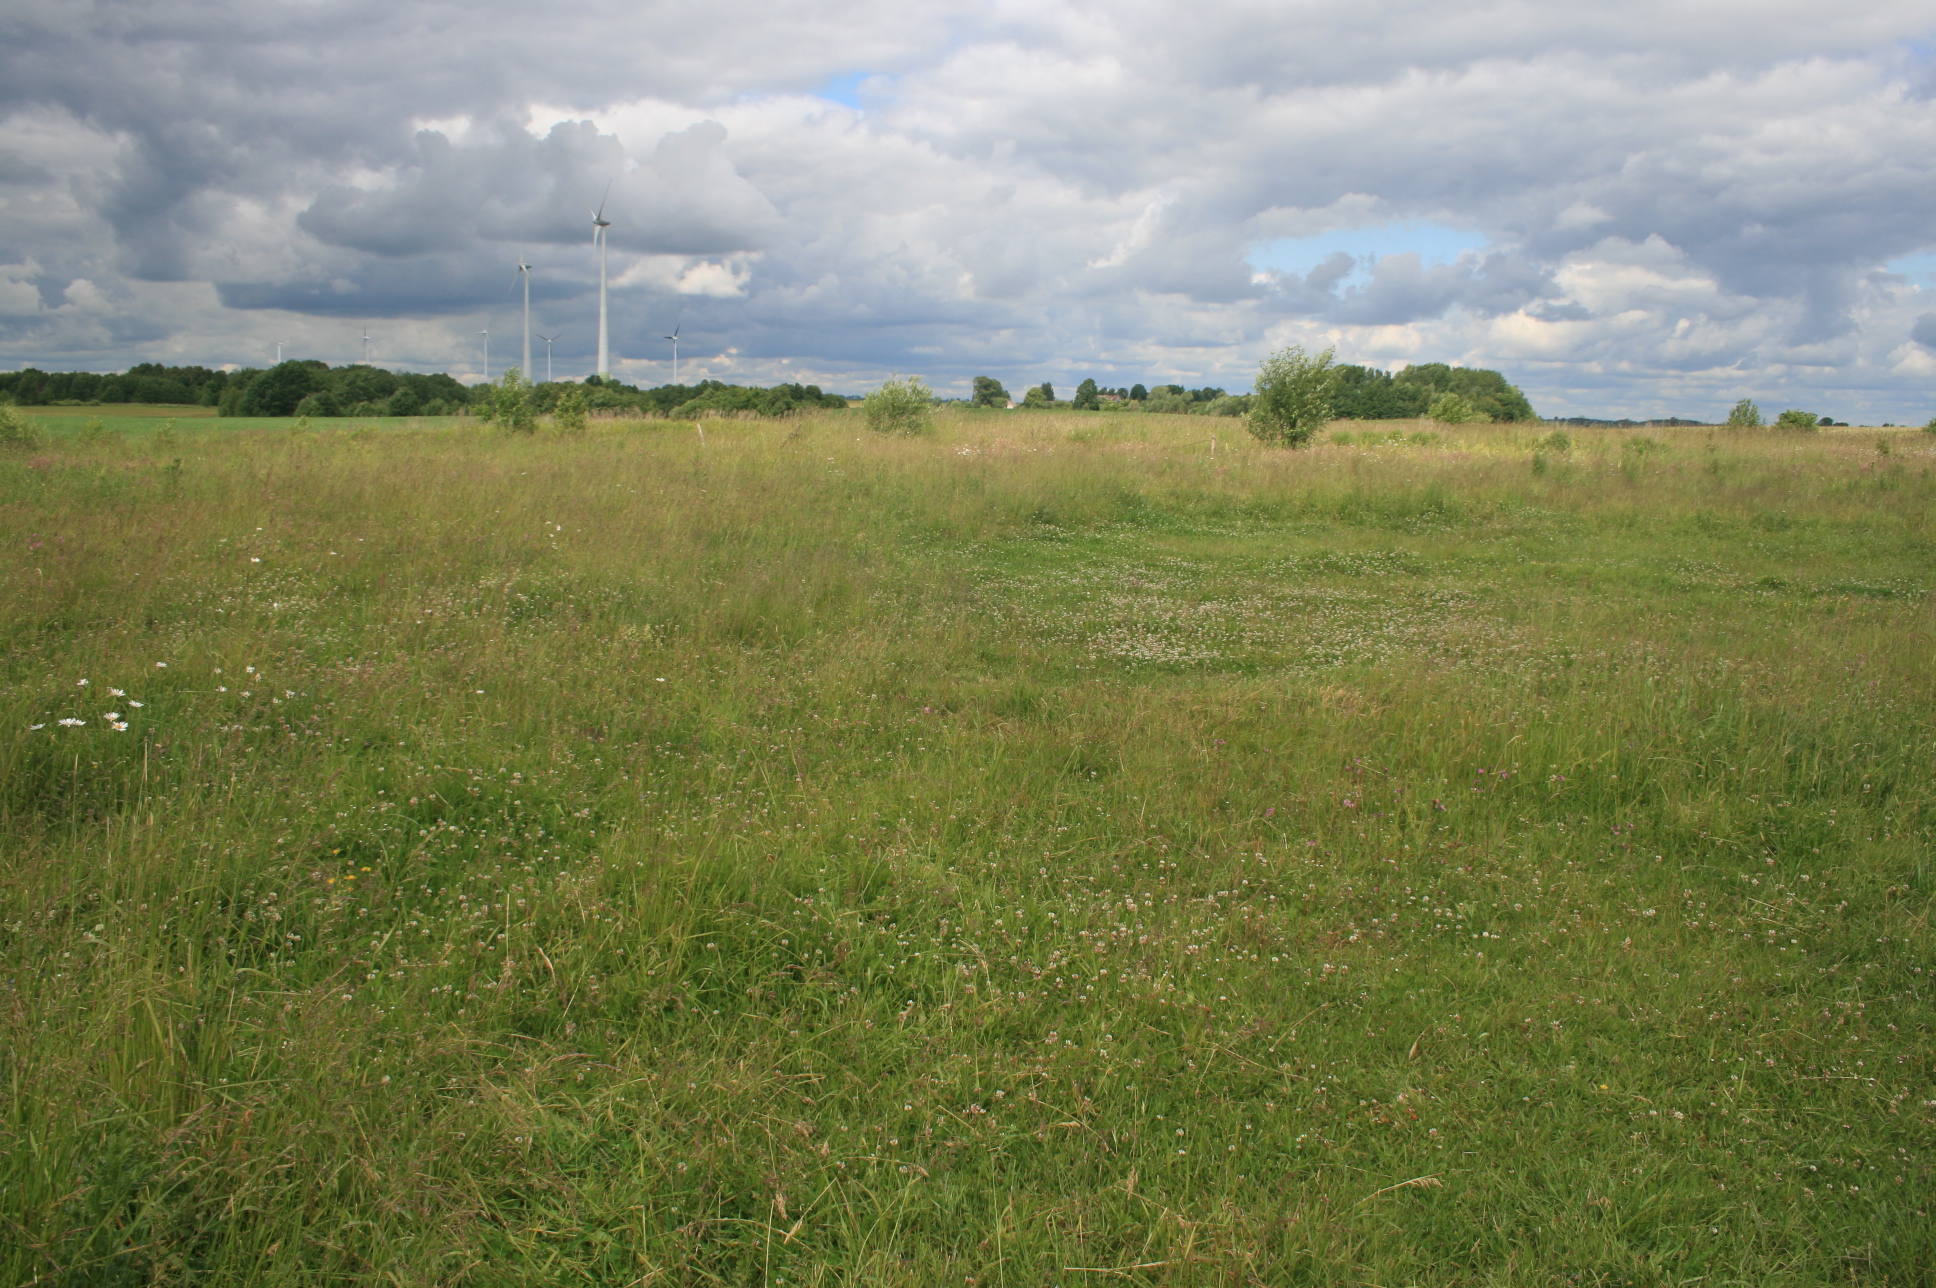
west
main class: Grassland
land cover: Grassland without tree/shrub cover
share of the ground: > 75 %
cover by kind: herbaceous plants 100 %
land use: Agriculture (excluding fallow land and kitchen gardens)
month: June
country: LT
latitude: 55.1966
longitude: 22.0733
